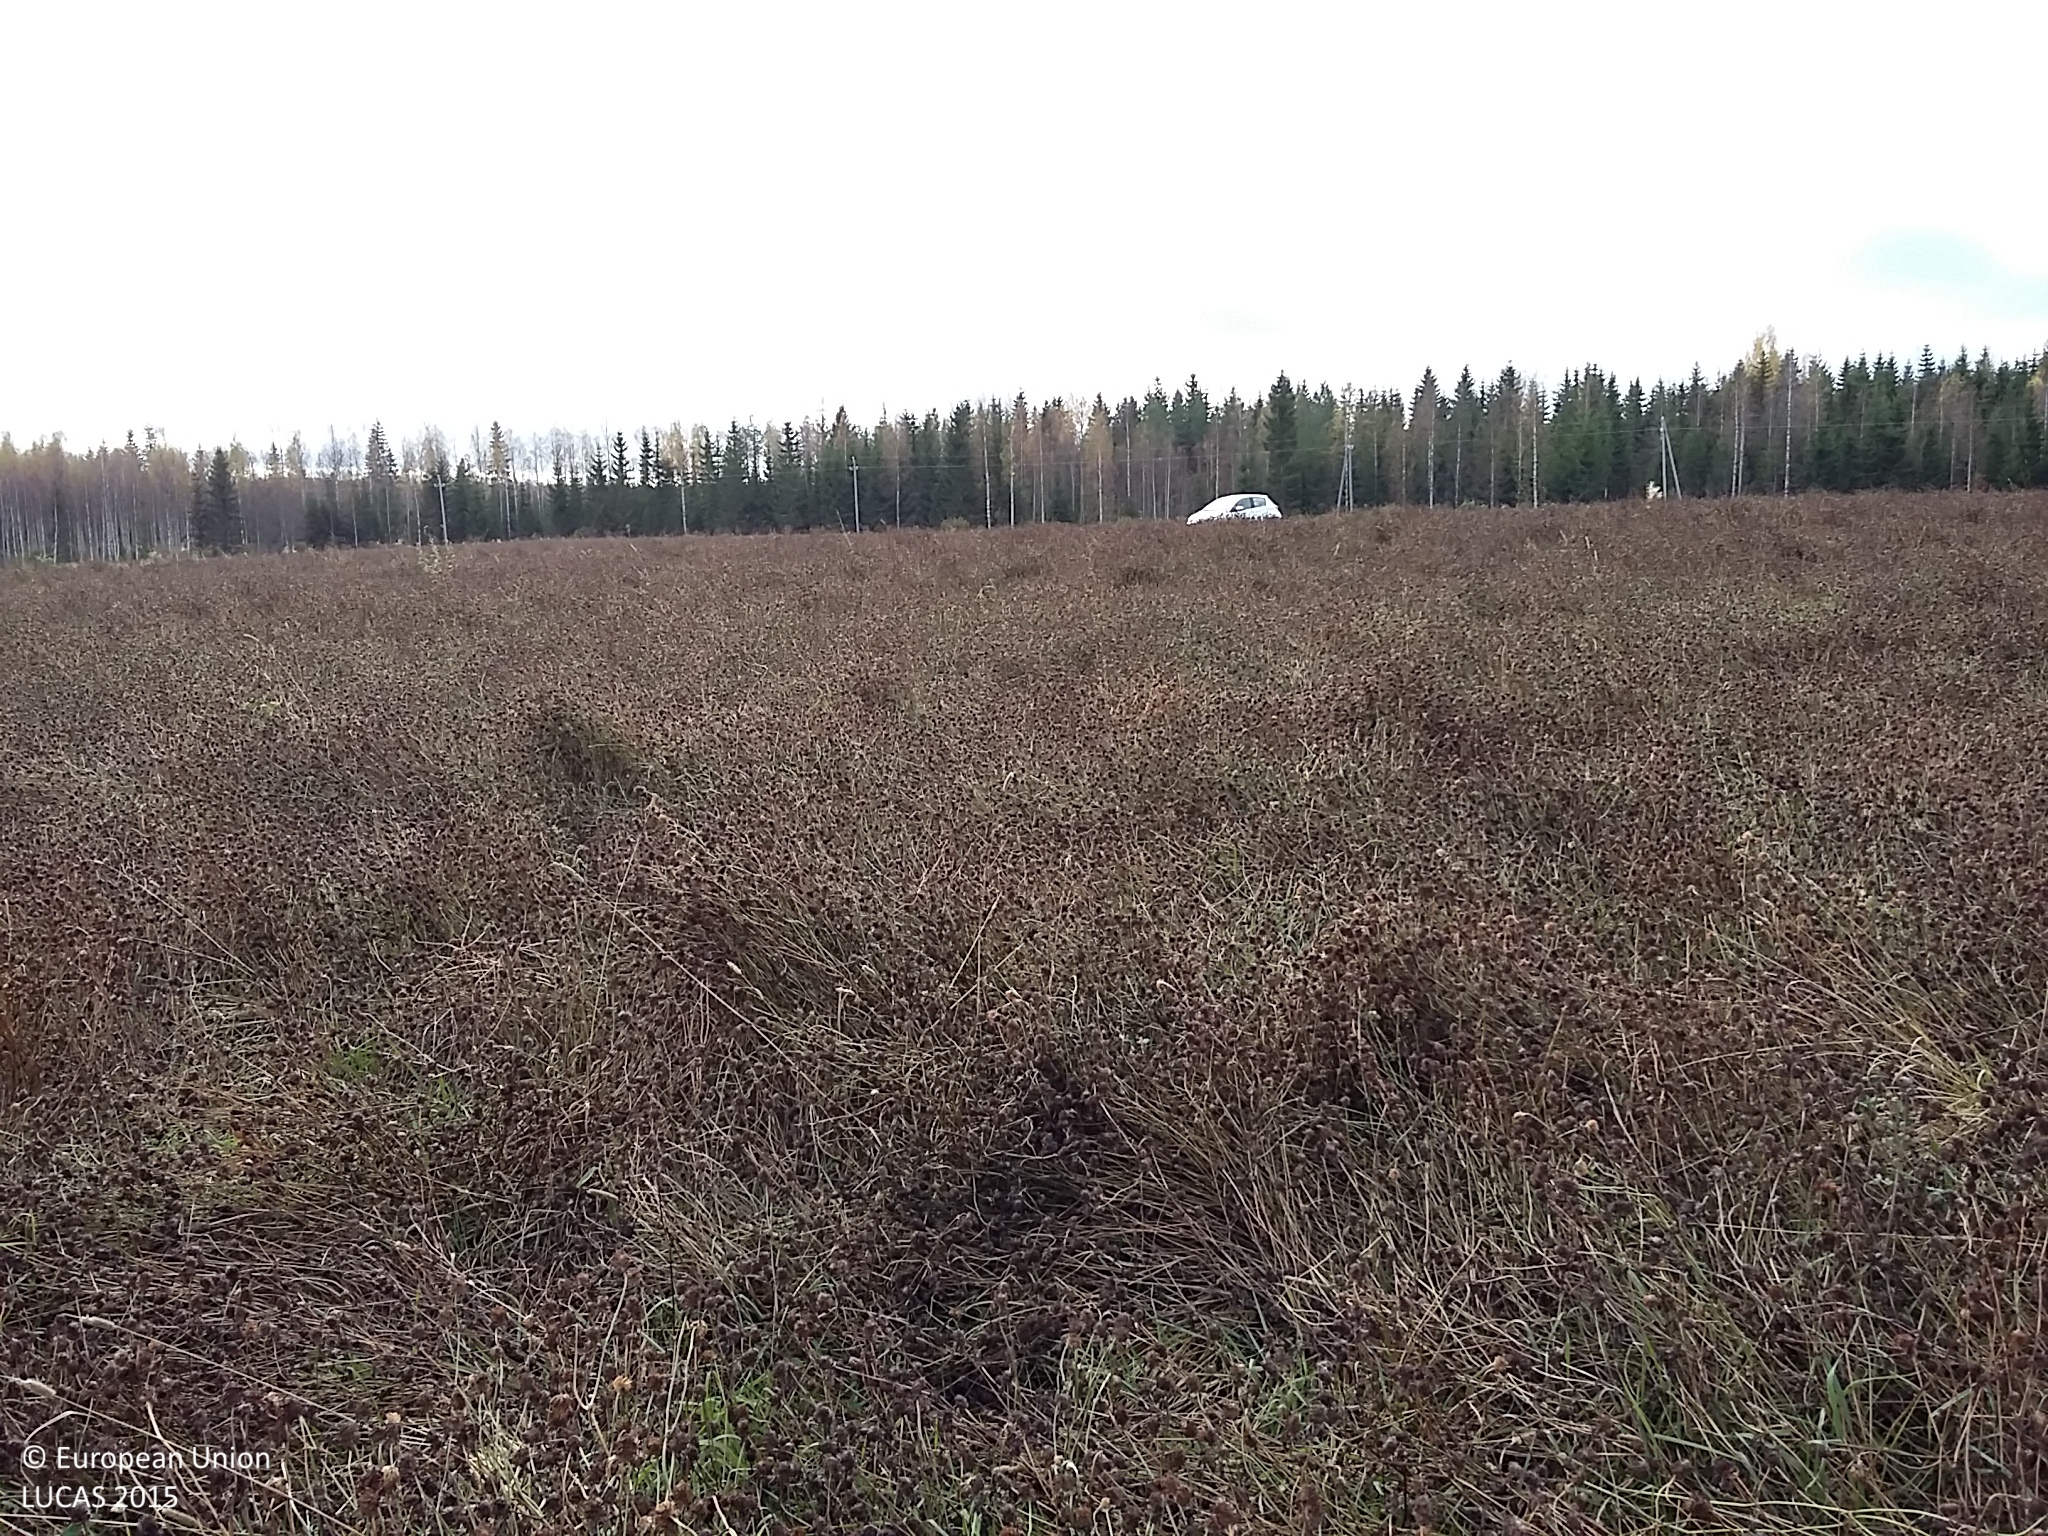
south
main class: Cropland
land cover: Other leguminous and mixtures for fodder
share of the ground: > 75 %
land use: Agriculture (excluding fallow land and kitchen gardens)
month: October
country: FI
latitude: 62.5481
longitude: 26.2891
